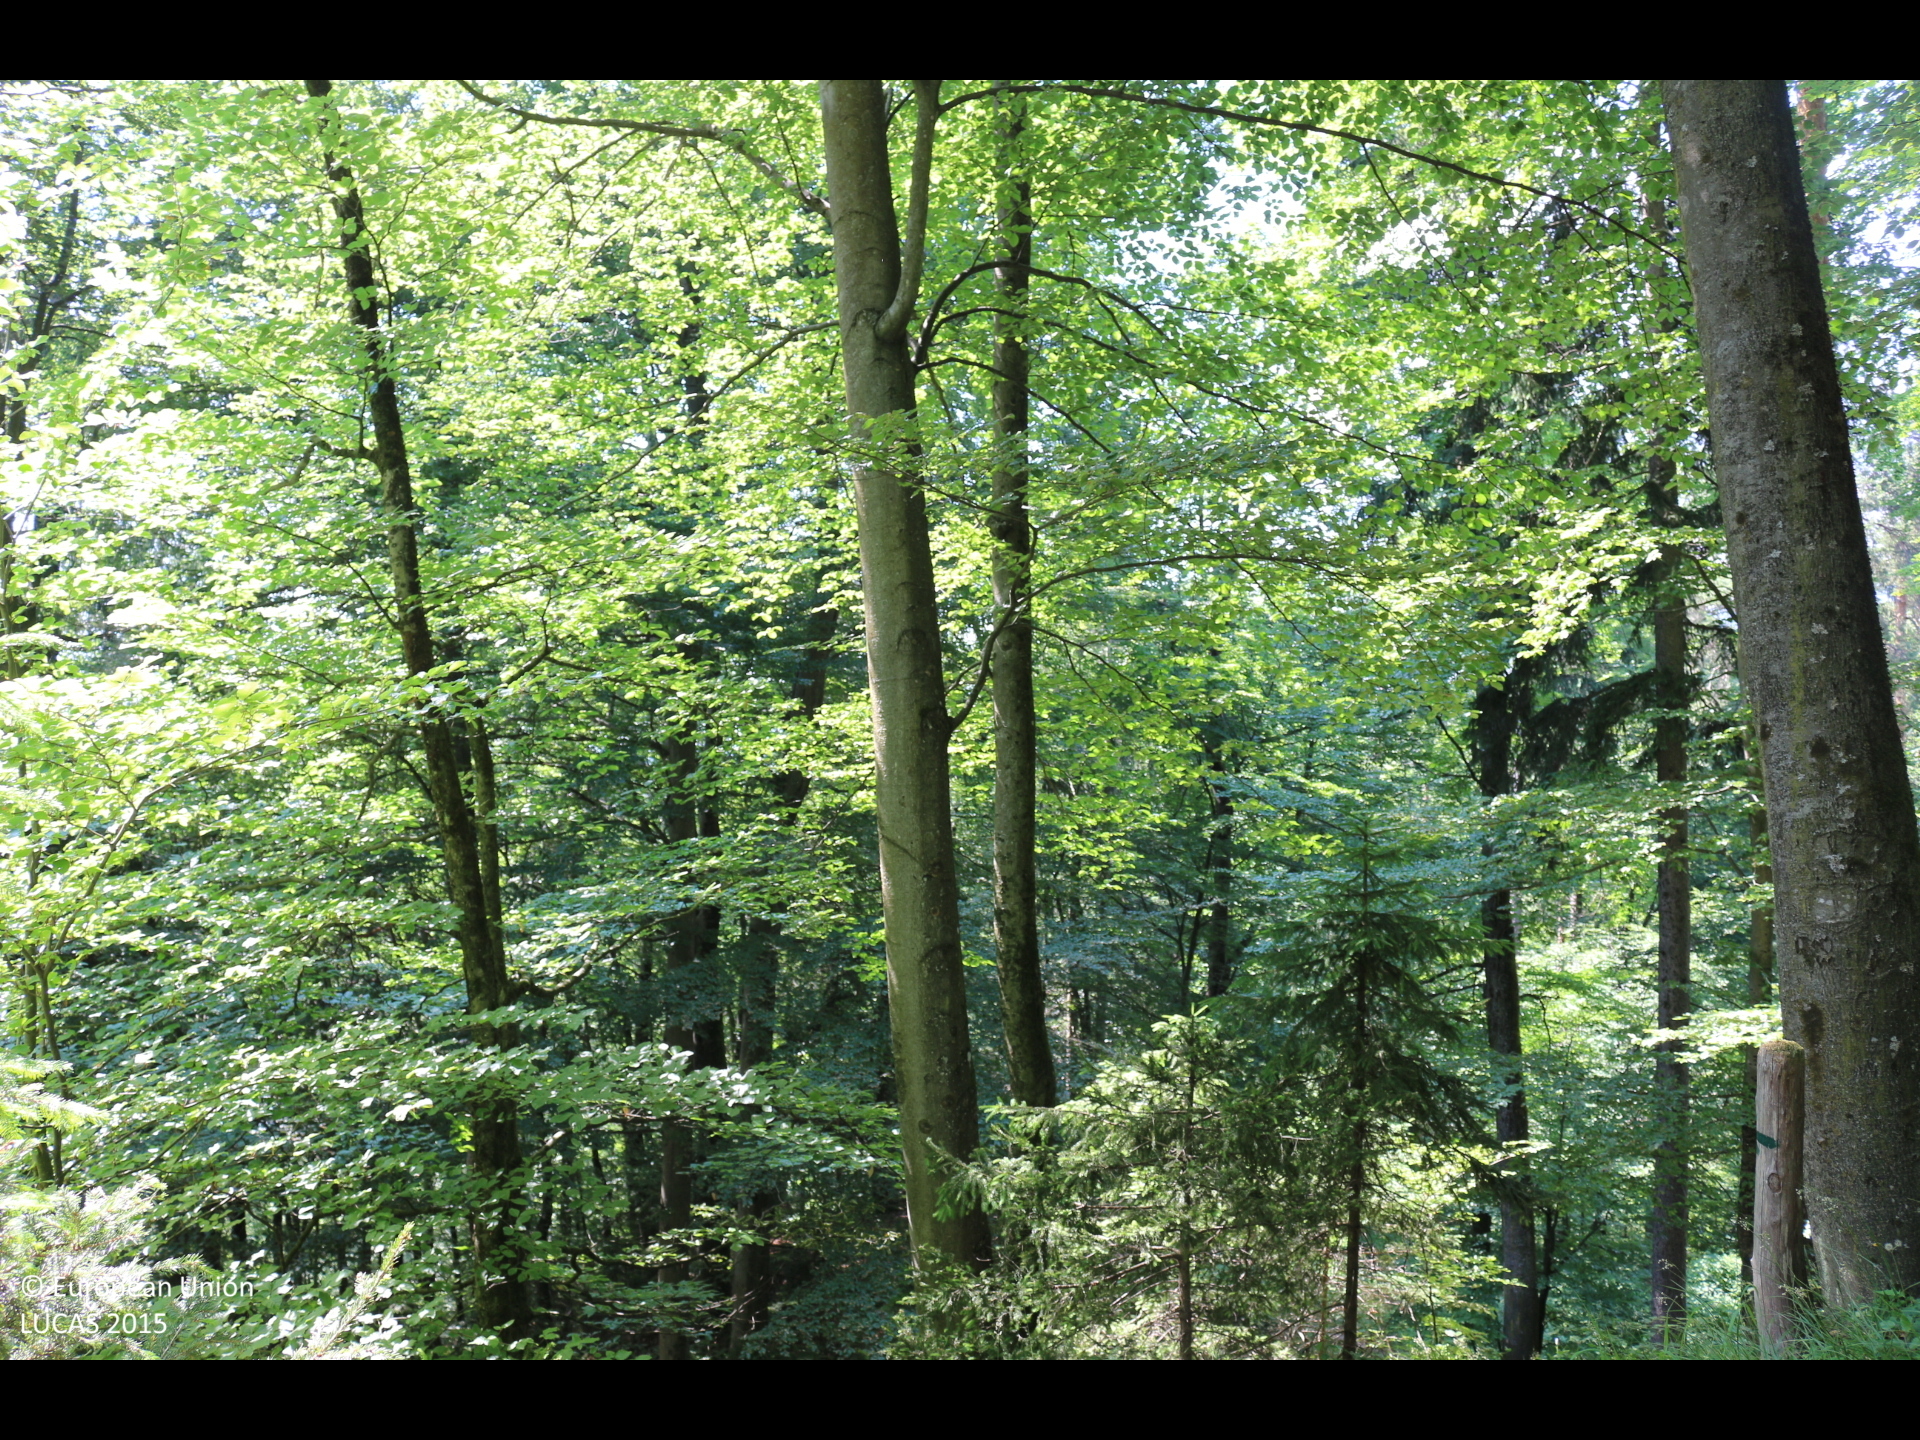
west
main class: Woodland
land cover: Broadleaved woodland
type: mountainous beech forest
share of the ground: > 75 %
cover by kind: broadleaved forest trees 95 %, coniferous forest trees 5 %
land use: Forestry
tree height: > 5 m
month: June
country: AT
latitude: 46.6217
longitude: 13.9281
